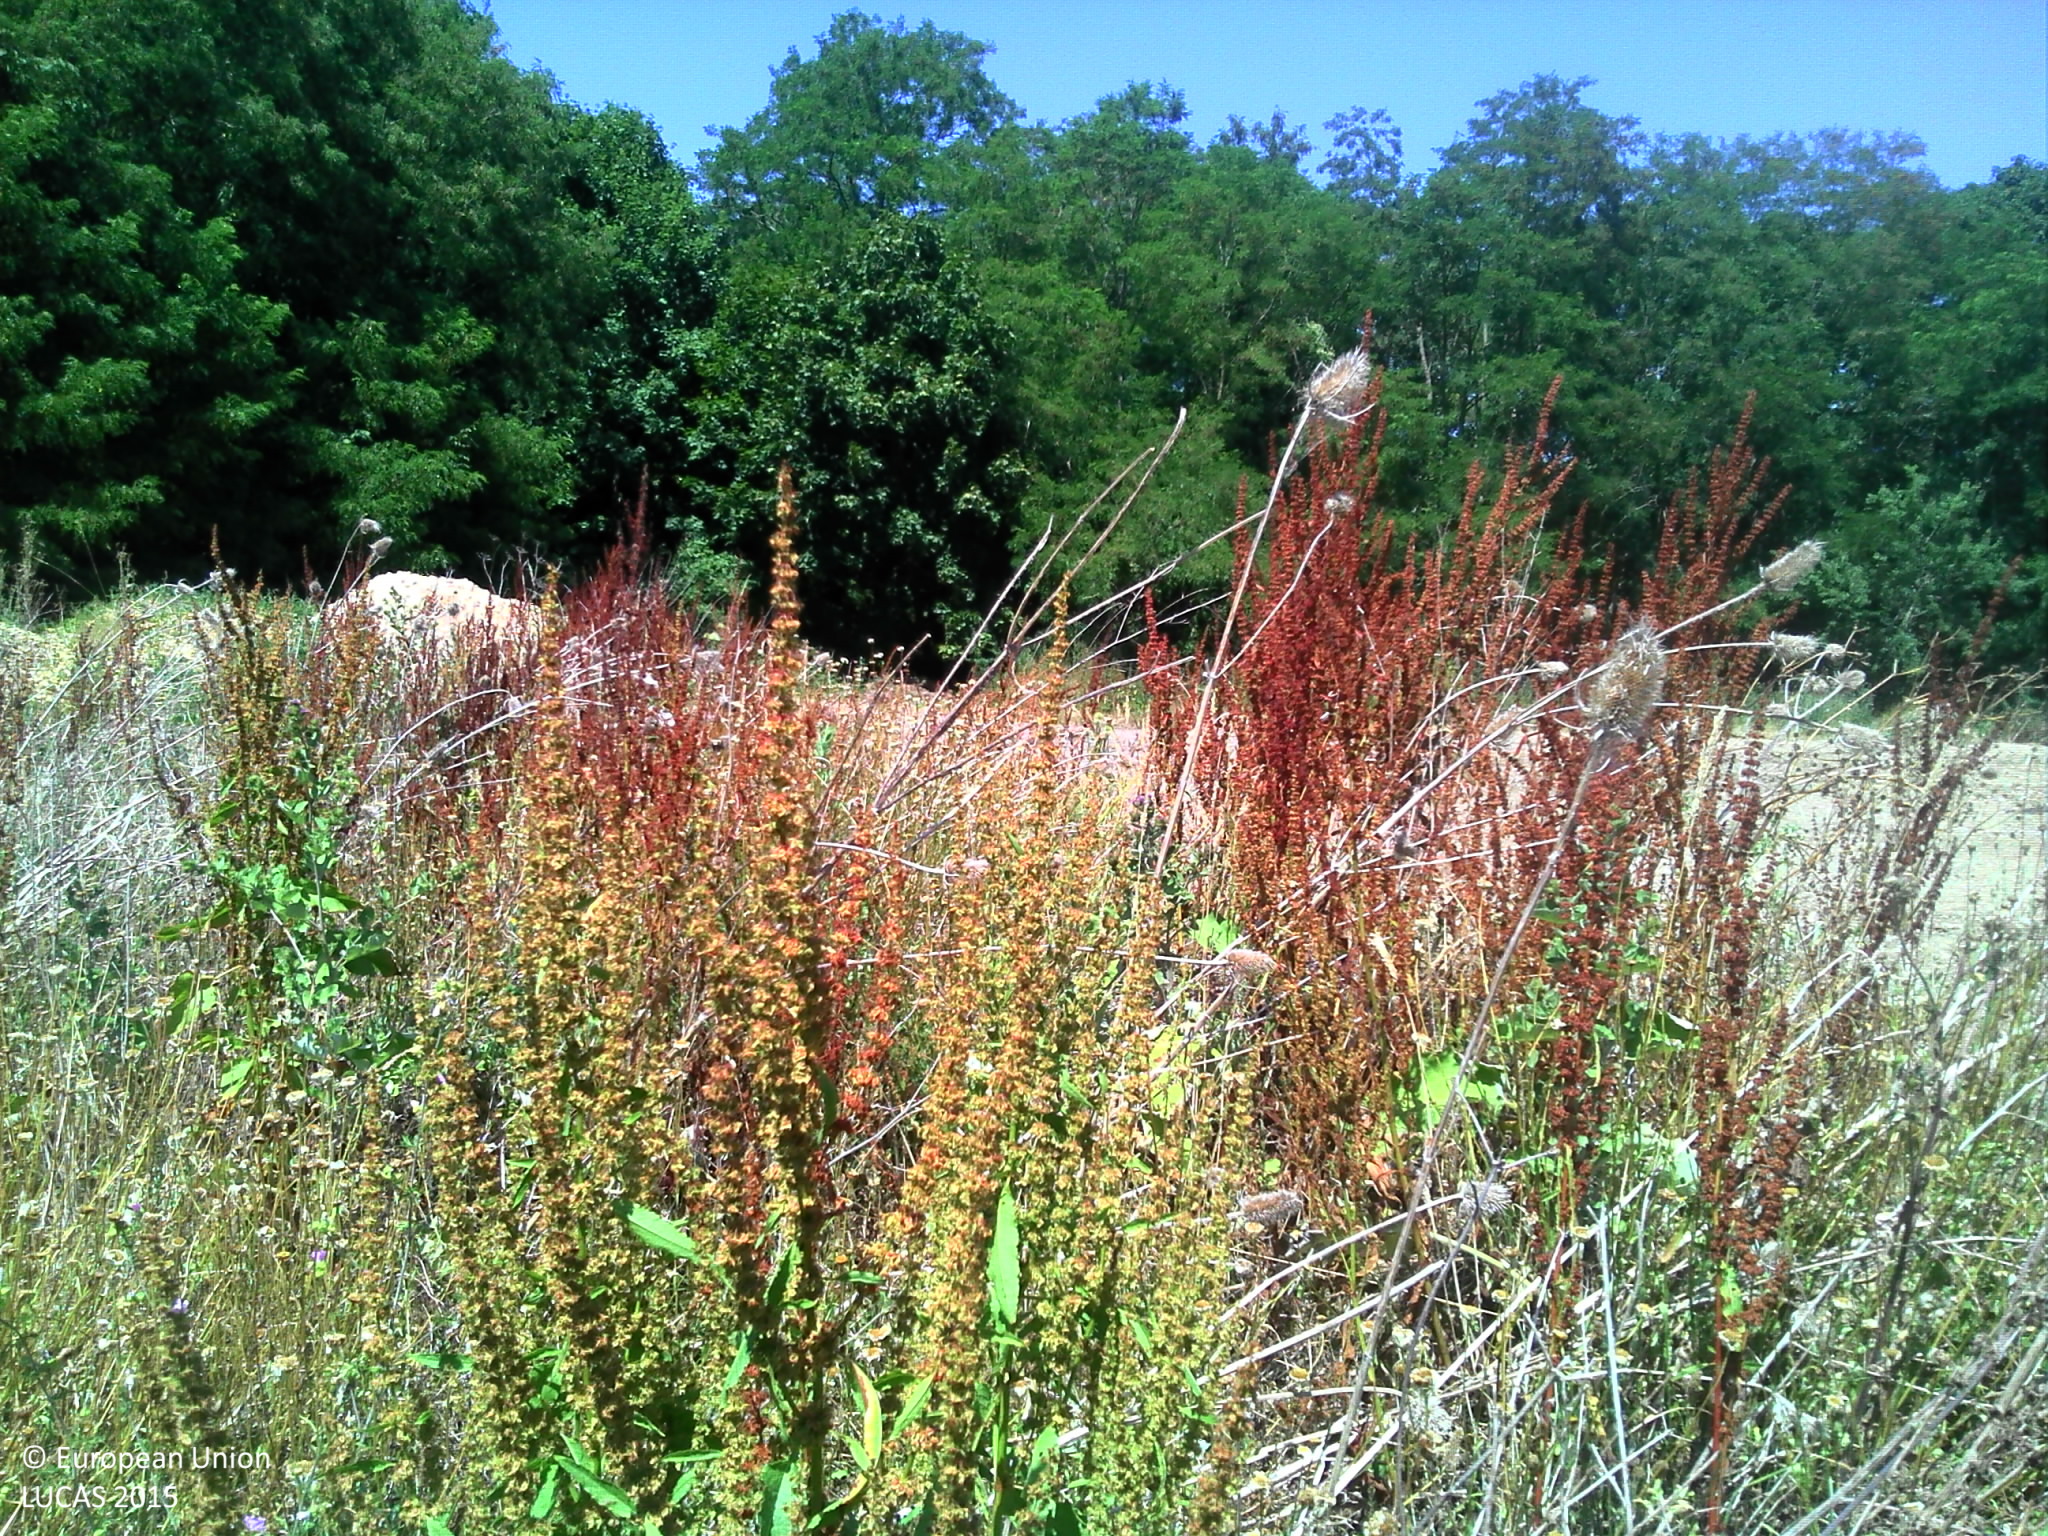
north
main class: Grassland
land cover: Spontaneously vegetated surfaces
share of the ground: > 75 %
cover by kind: herbaceous plants 80 %, consolidated bare surface 20 %
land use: Abandoned areas
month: July
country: FR
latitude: 49.2330
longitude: 1.2595
